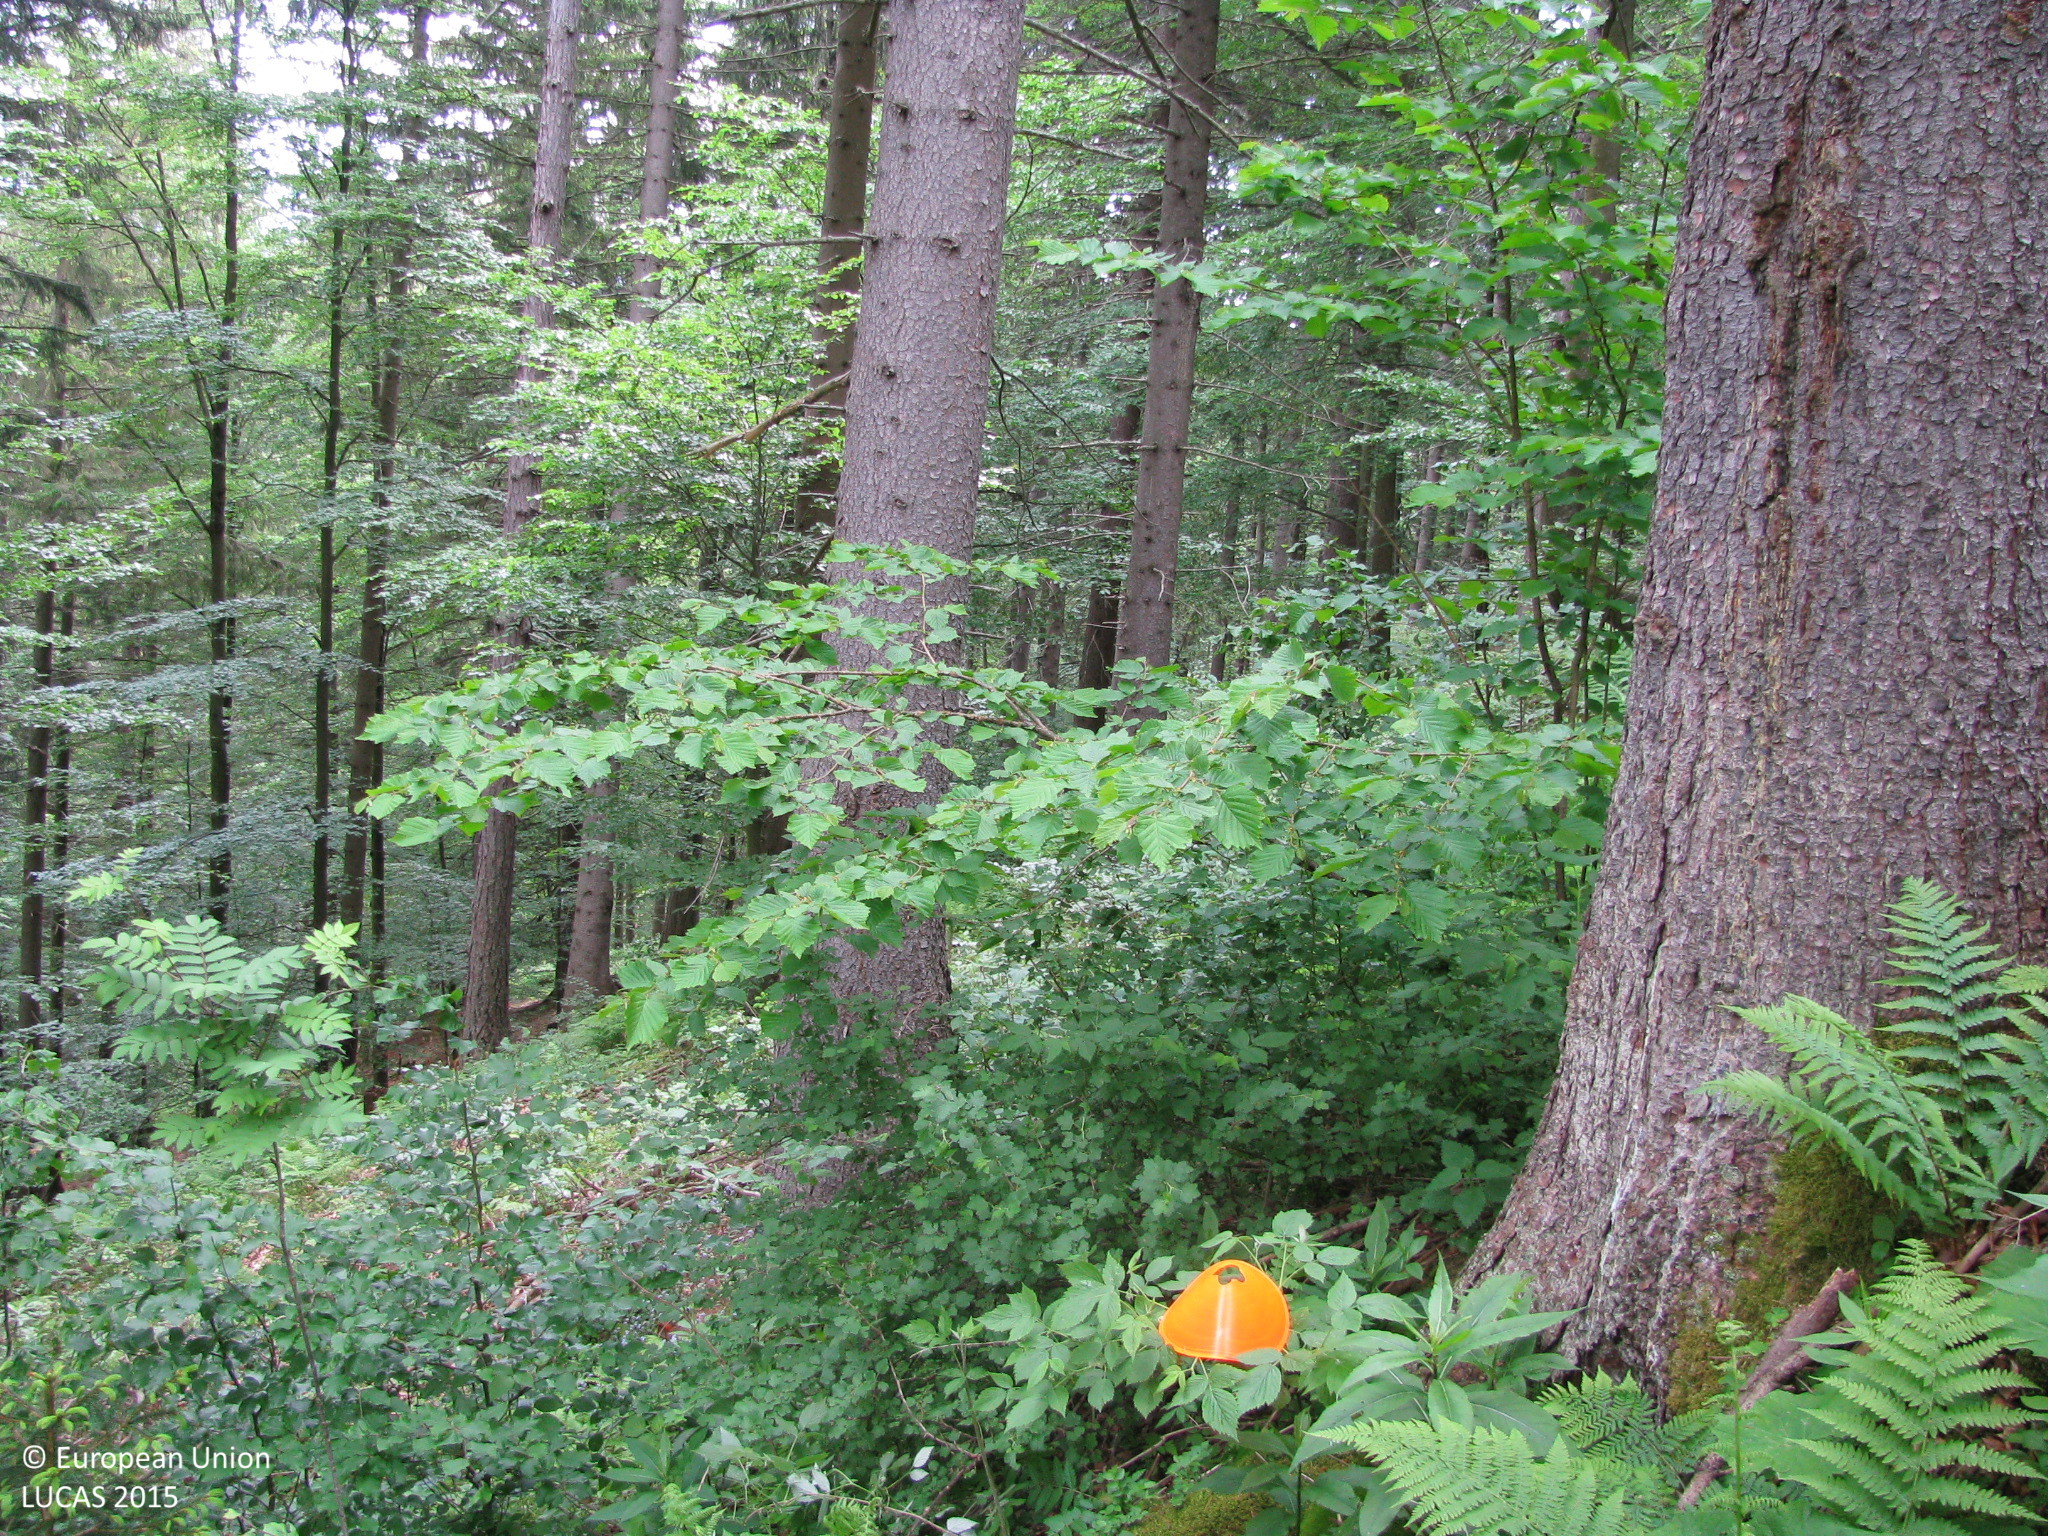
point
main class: Woodland
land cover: Spruce dominated mixed woodland
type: mountainous beech forest
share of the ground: > 75 %
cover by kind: broadleaved forest trees 45 %, coniferous forest trees 40 %, herbaceous plants 10 %, lichens and mosses 5 %
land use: Forestry
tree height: > 5 m
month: June
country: AT
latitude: 47.4622
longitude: 14.9744
